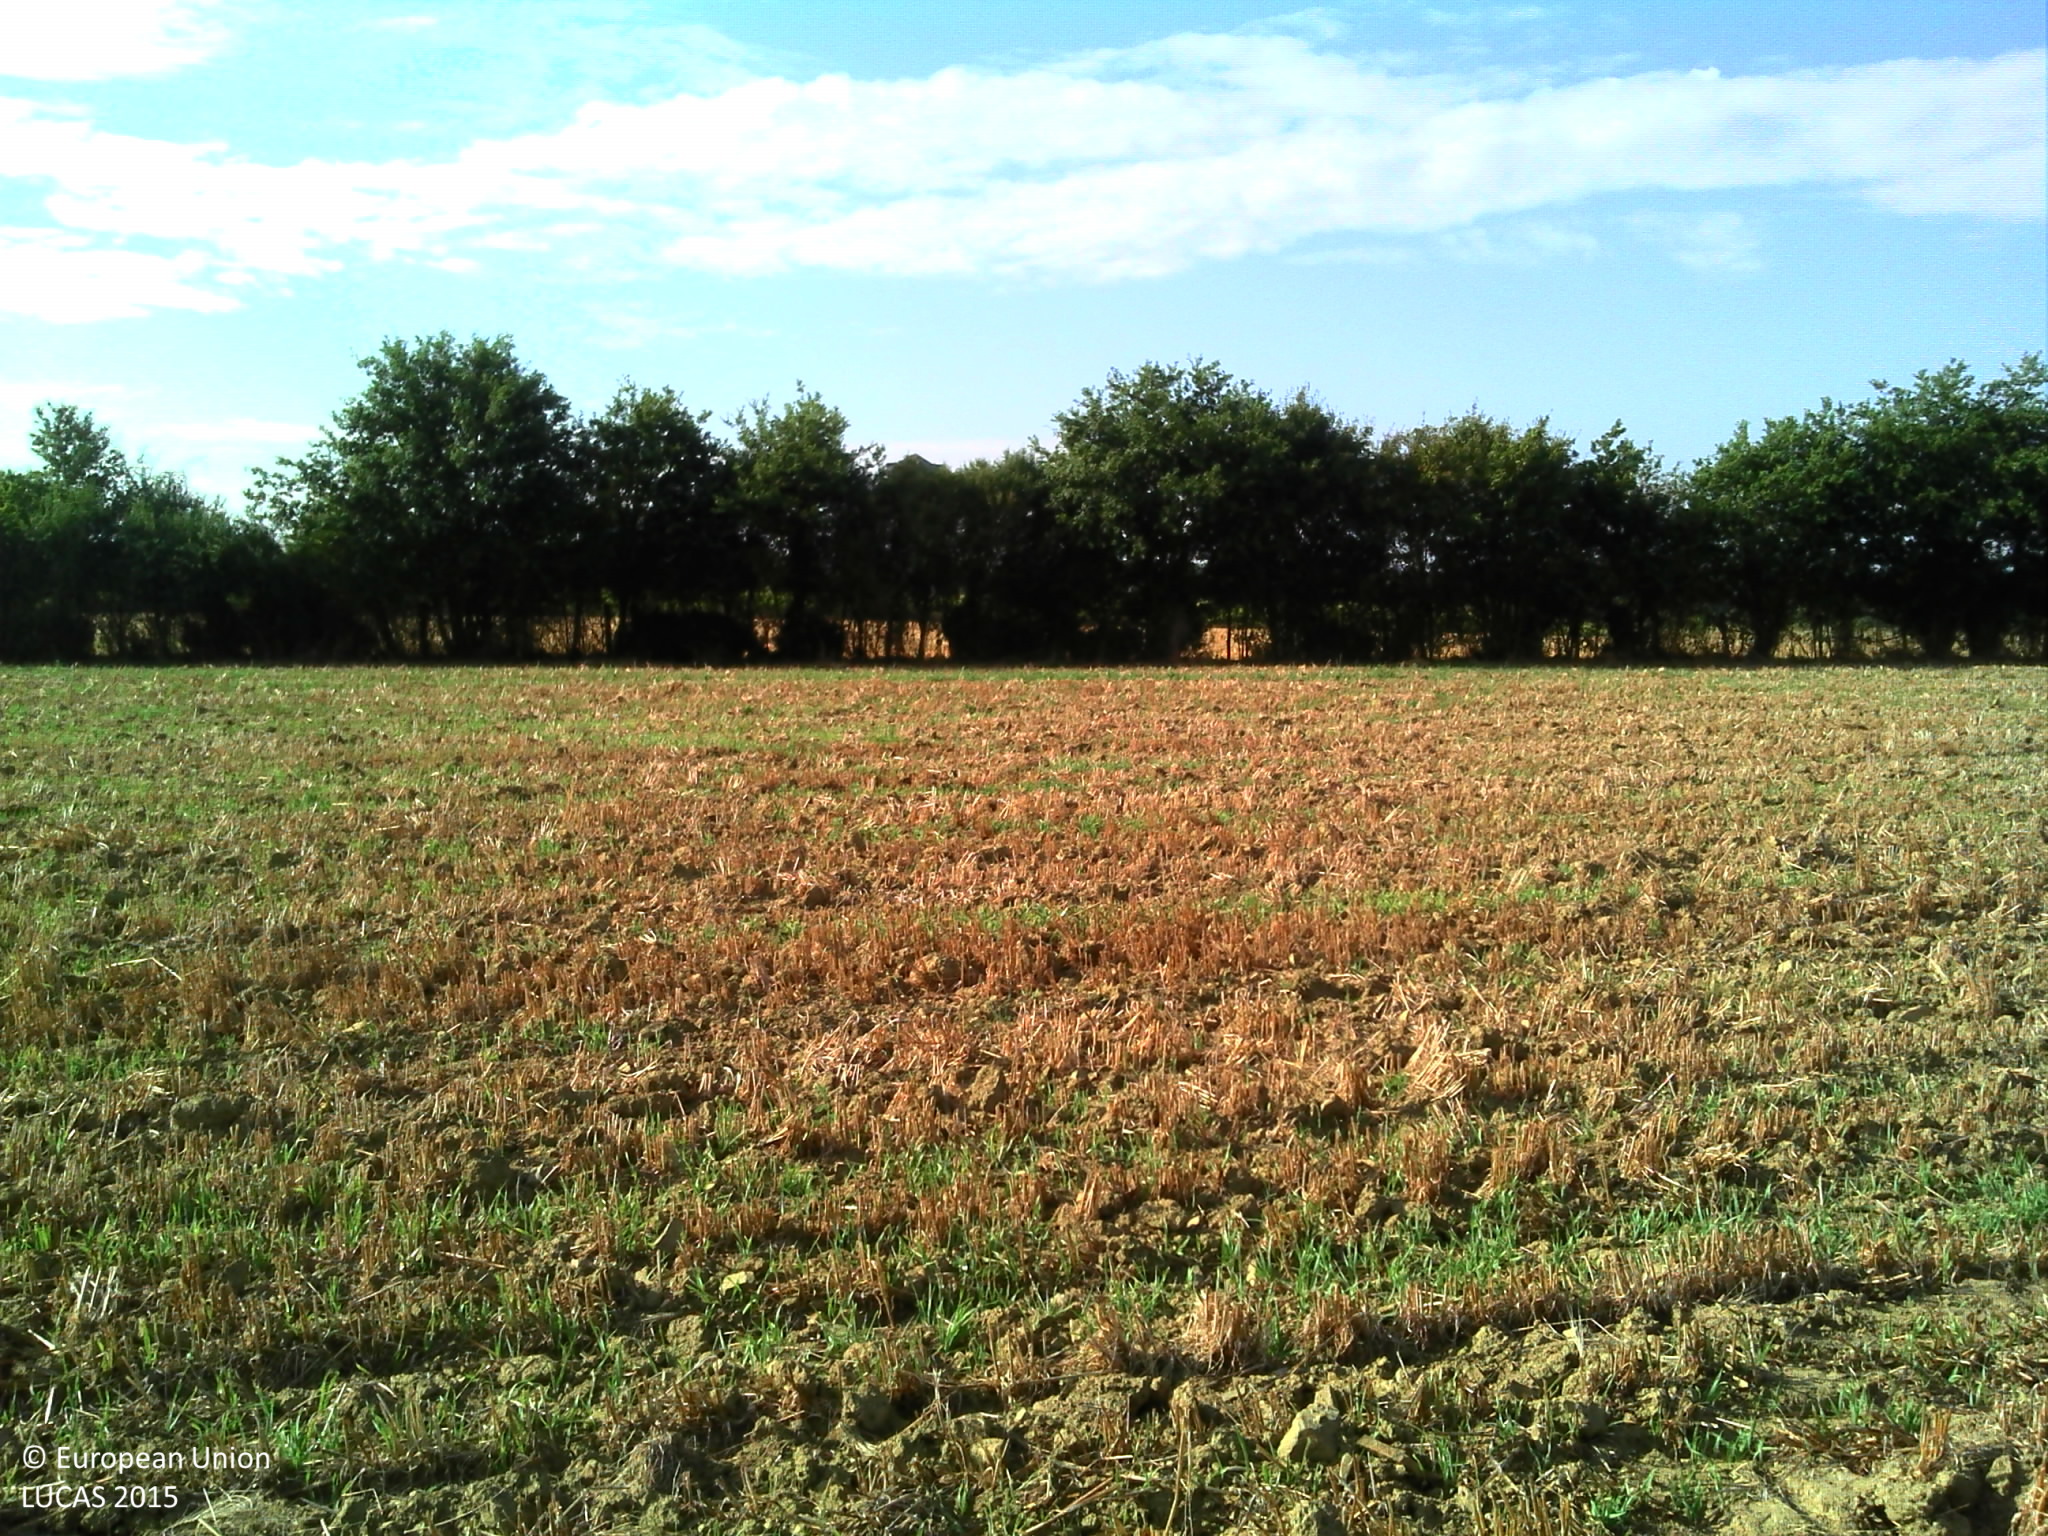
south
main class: Cropland
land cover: Barley
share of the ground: < 10 %
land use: Agriculture (excluding fallow land and kitchen gardens)
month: August
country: FR
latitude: 47.4203
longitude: -1.8307
